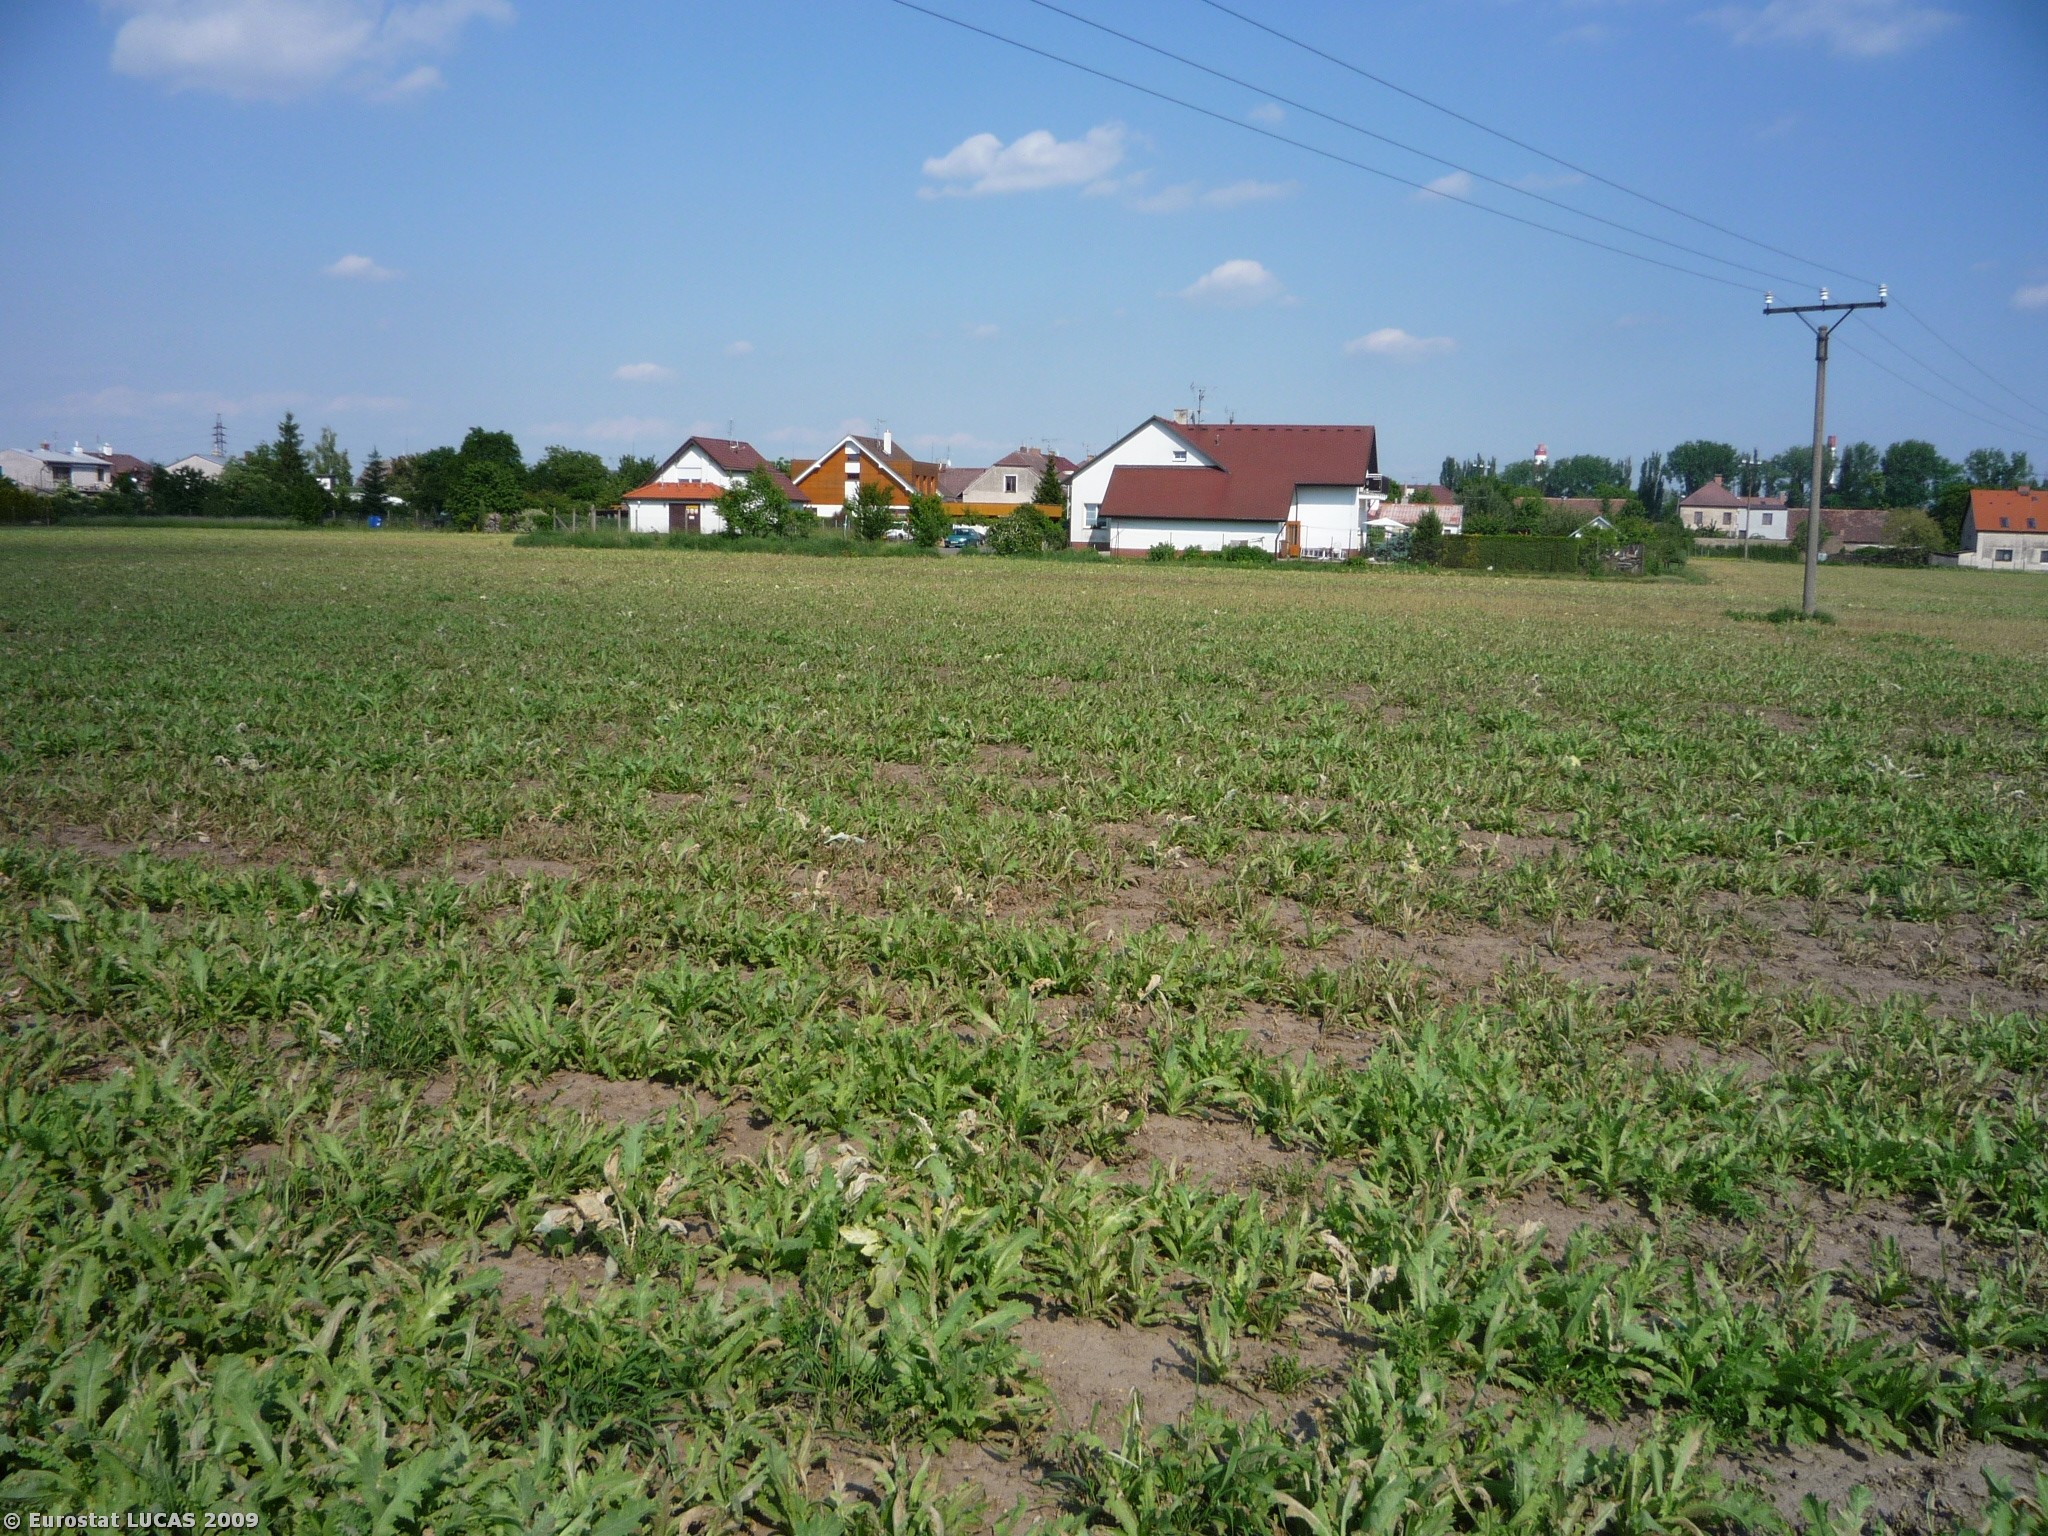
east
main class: Cropland
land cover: Other fibre and oleaginous crops
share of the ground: > 75 %
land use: Agriculture (excluding fallow land and kitchen gardens)
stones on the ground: < 10 %
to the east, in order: Other fibre and oleaginous crops; Electric lines; Other fibre and oleaginous crops; Grassland with sparse tree/shrub cover; Fences; Artificial constructions in urban areas
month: May
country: CZ
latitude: 50.2173
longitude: 15.7930
